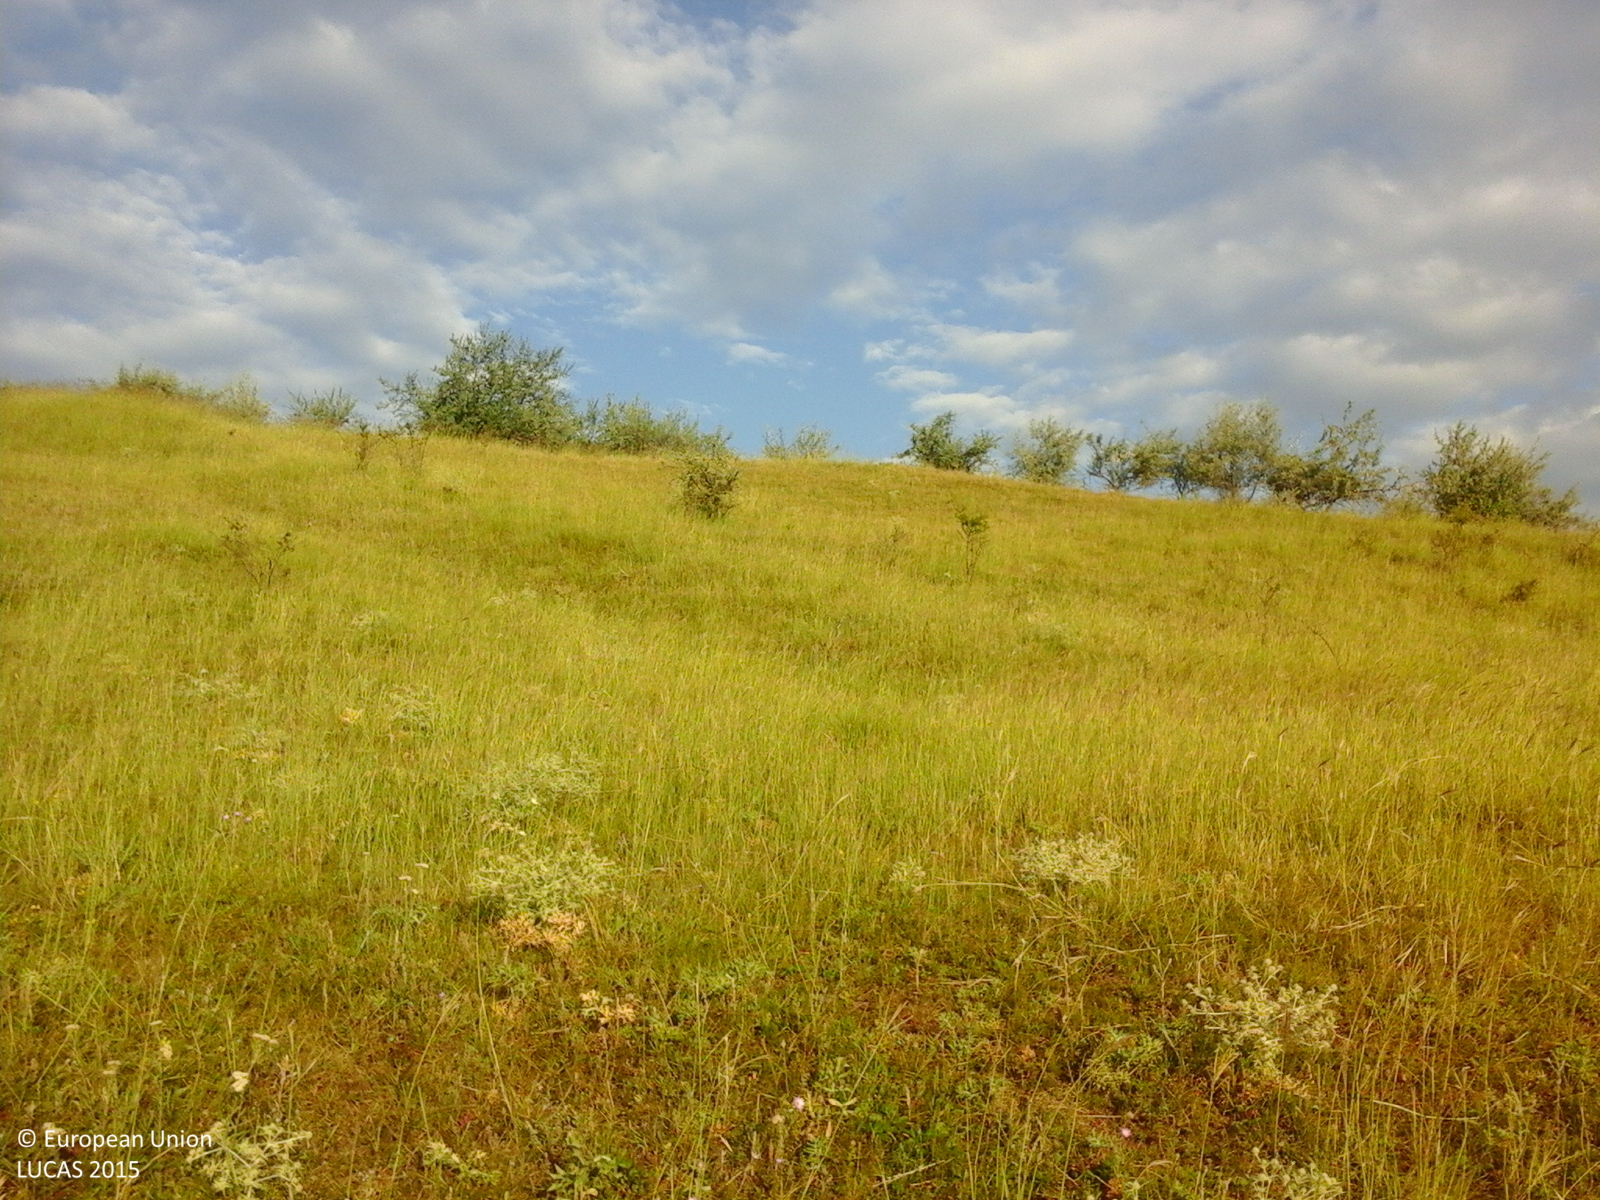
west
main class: Grassland
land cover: Grassland without tree/shrub cover
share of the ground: > 75 %
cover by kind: herbaceous plants 100 %
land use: Agriculture (excluding fallow land and kitchen gardens)
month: July
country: RO
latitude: 46.2524
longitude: 27.7446
